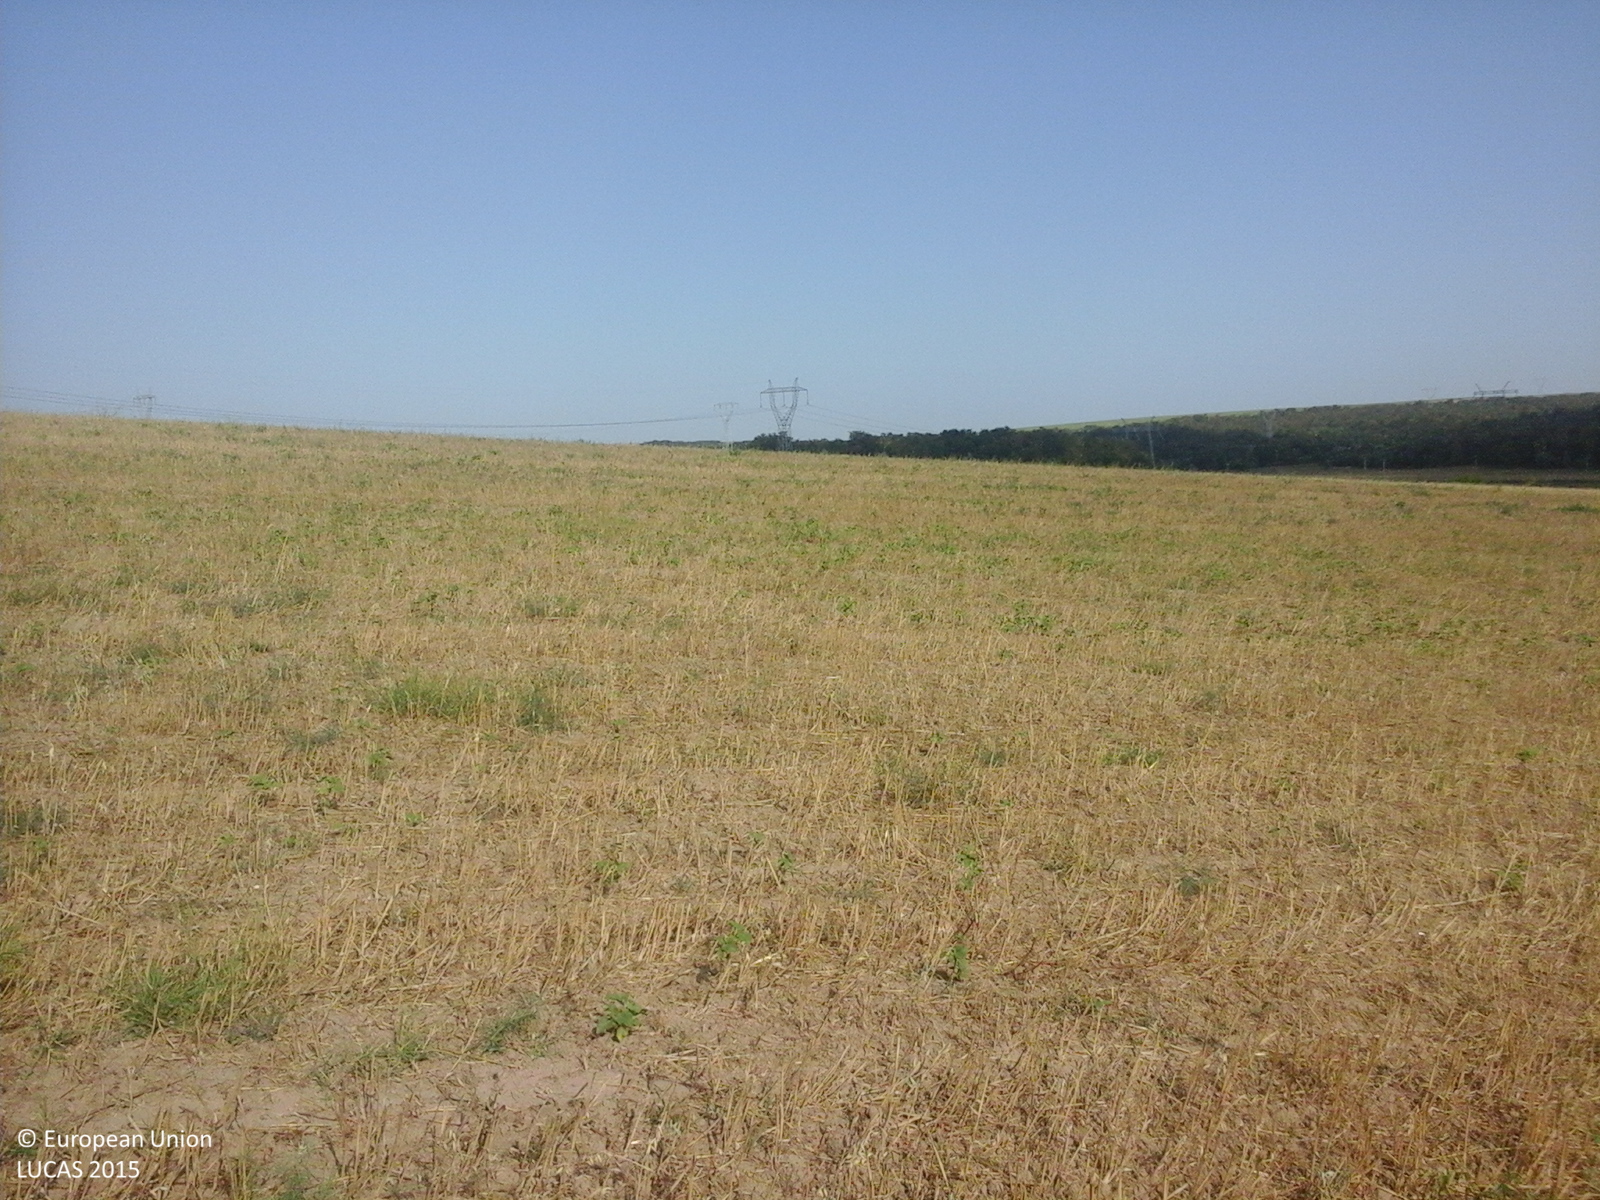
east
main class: Cropland
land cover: Oats
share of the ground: 25 - 50 %
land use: Agriculture (excluding fallow land and kitchen gardens)
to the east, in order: Oats; Grassland without tree/shrub cover; Spontaneously vegetated surfaces; Common wheat
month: August
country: RO
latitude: 44.5941
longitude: 28.0616
